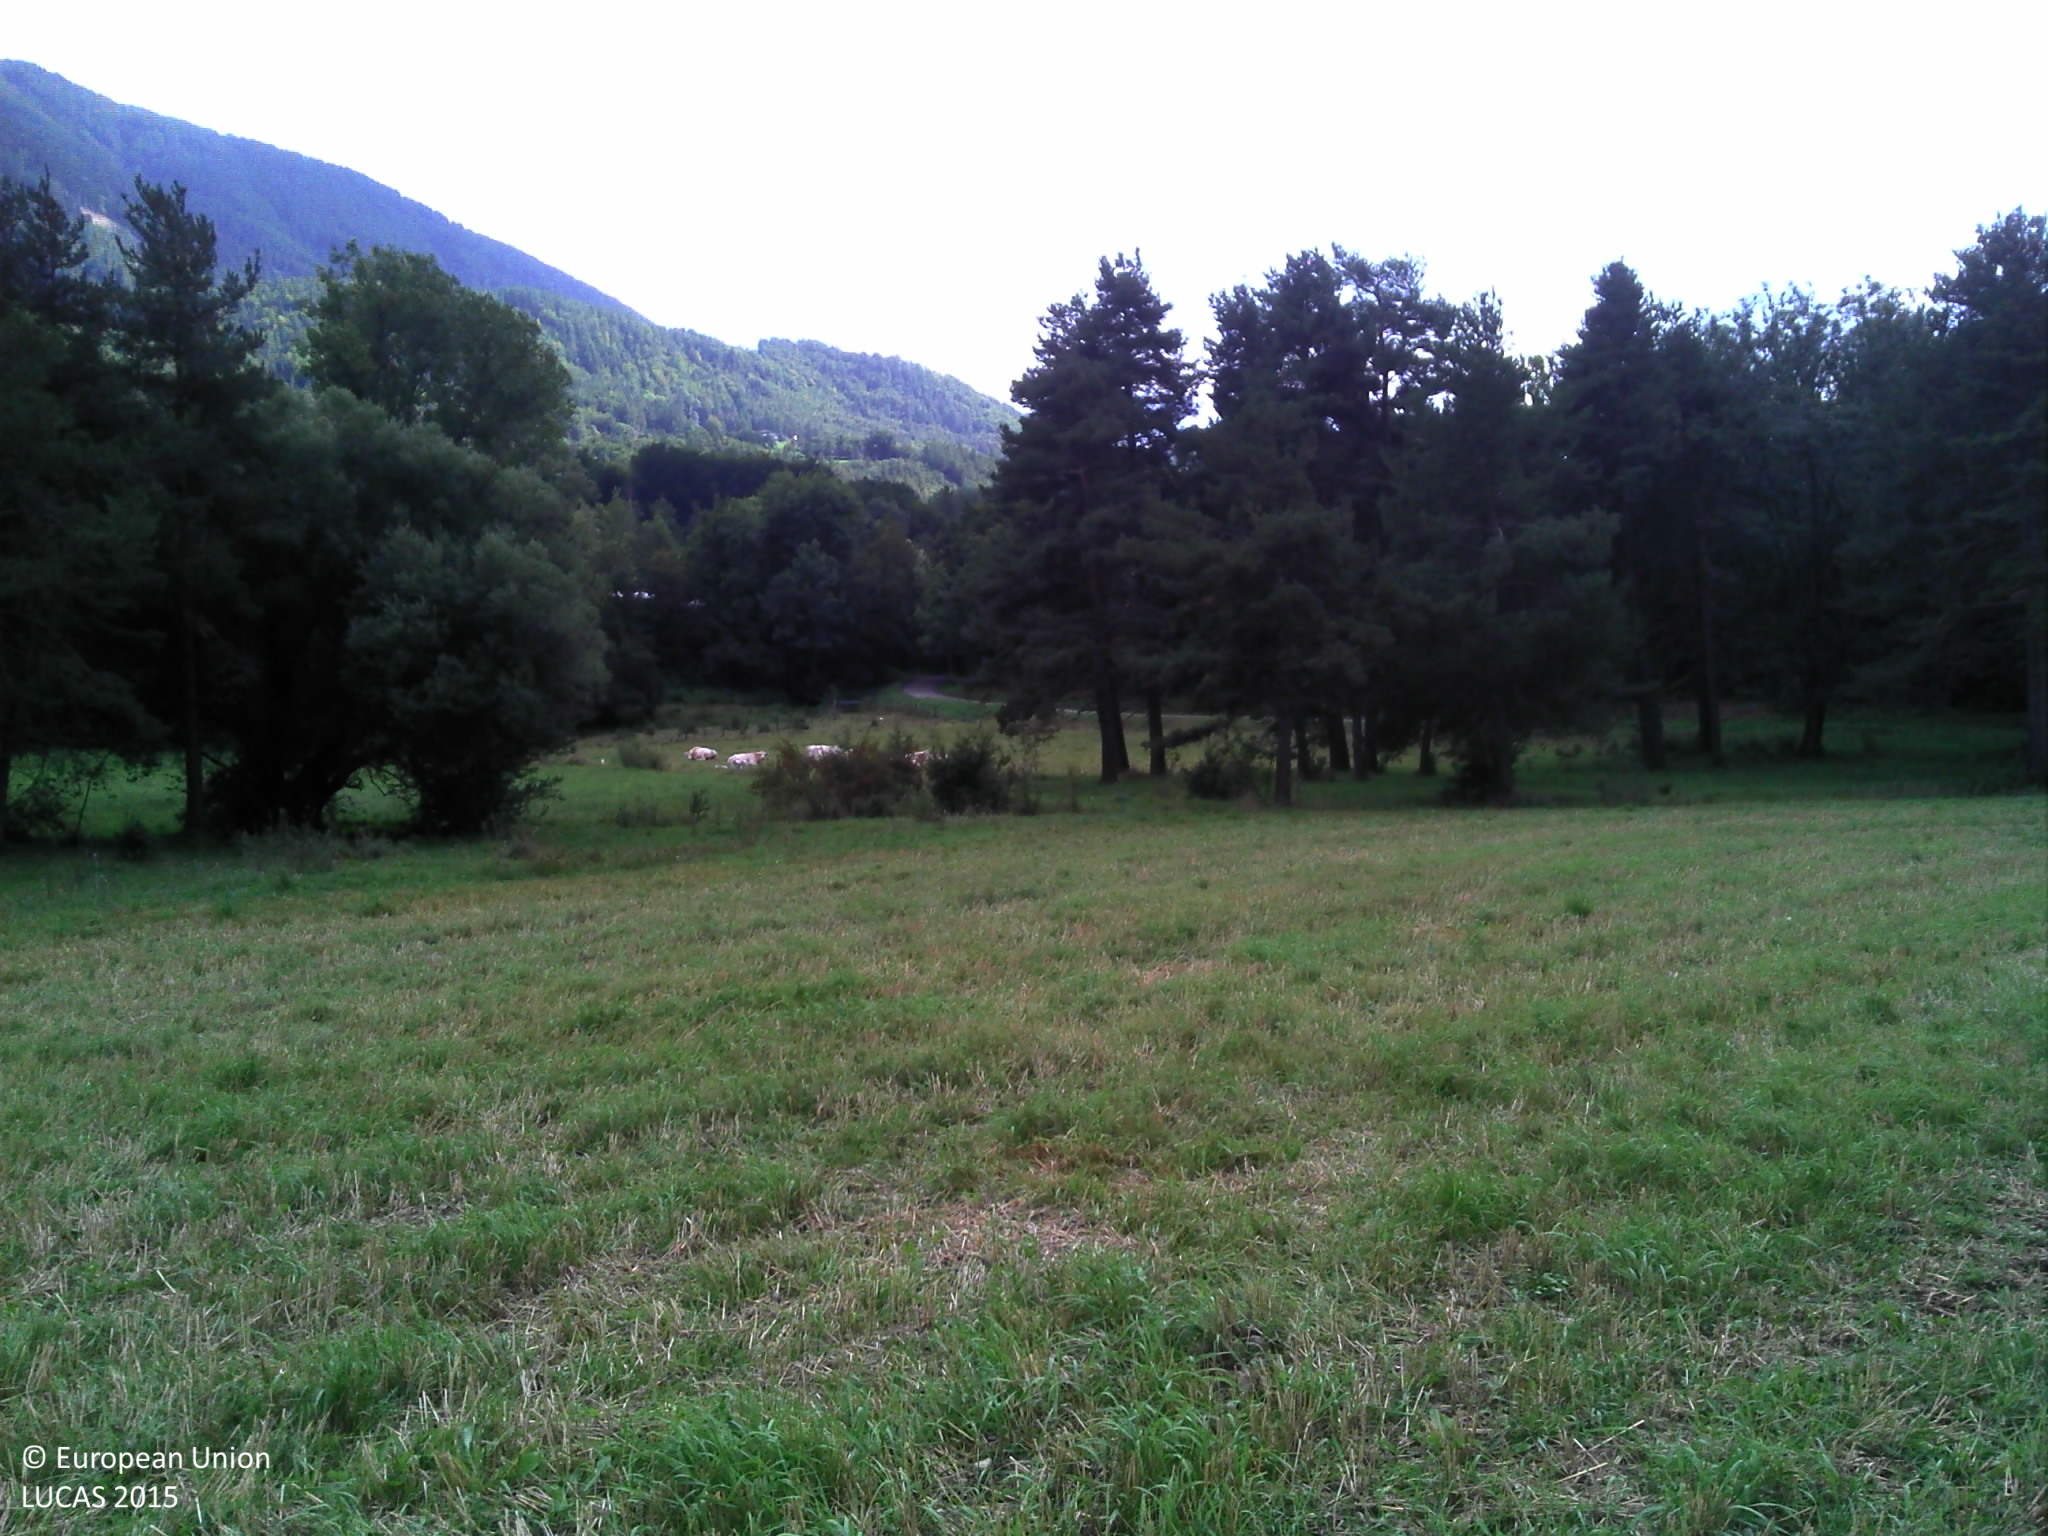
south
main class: Cropland
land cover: Common wheat
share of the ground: > 75 %
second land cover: Spontaneously vegetated surfaces
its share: > 75 %
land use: Agriculture (excluding fallow land and kitchen gardens)
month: September
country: FR
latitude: 44.6605
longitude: 6.2102
